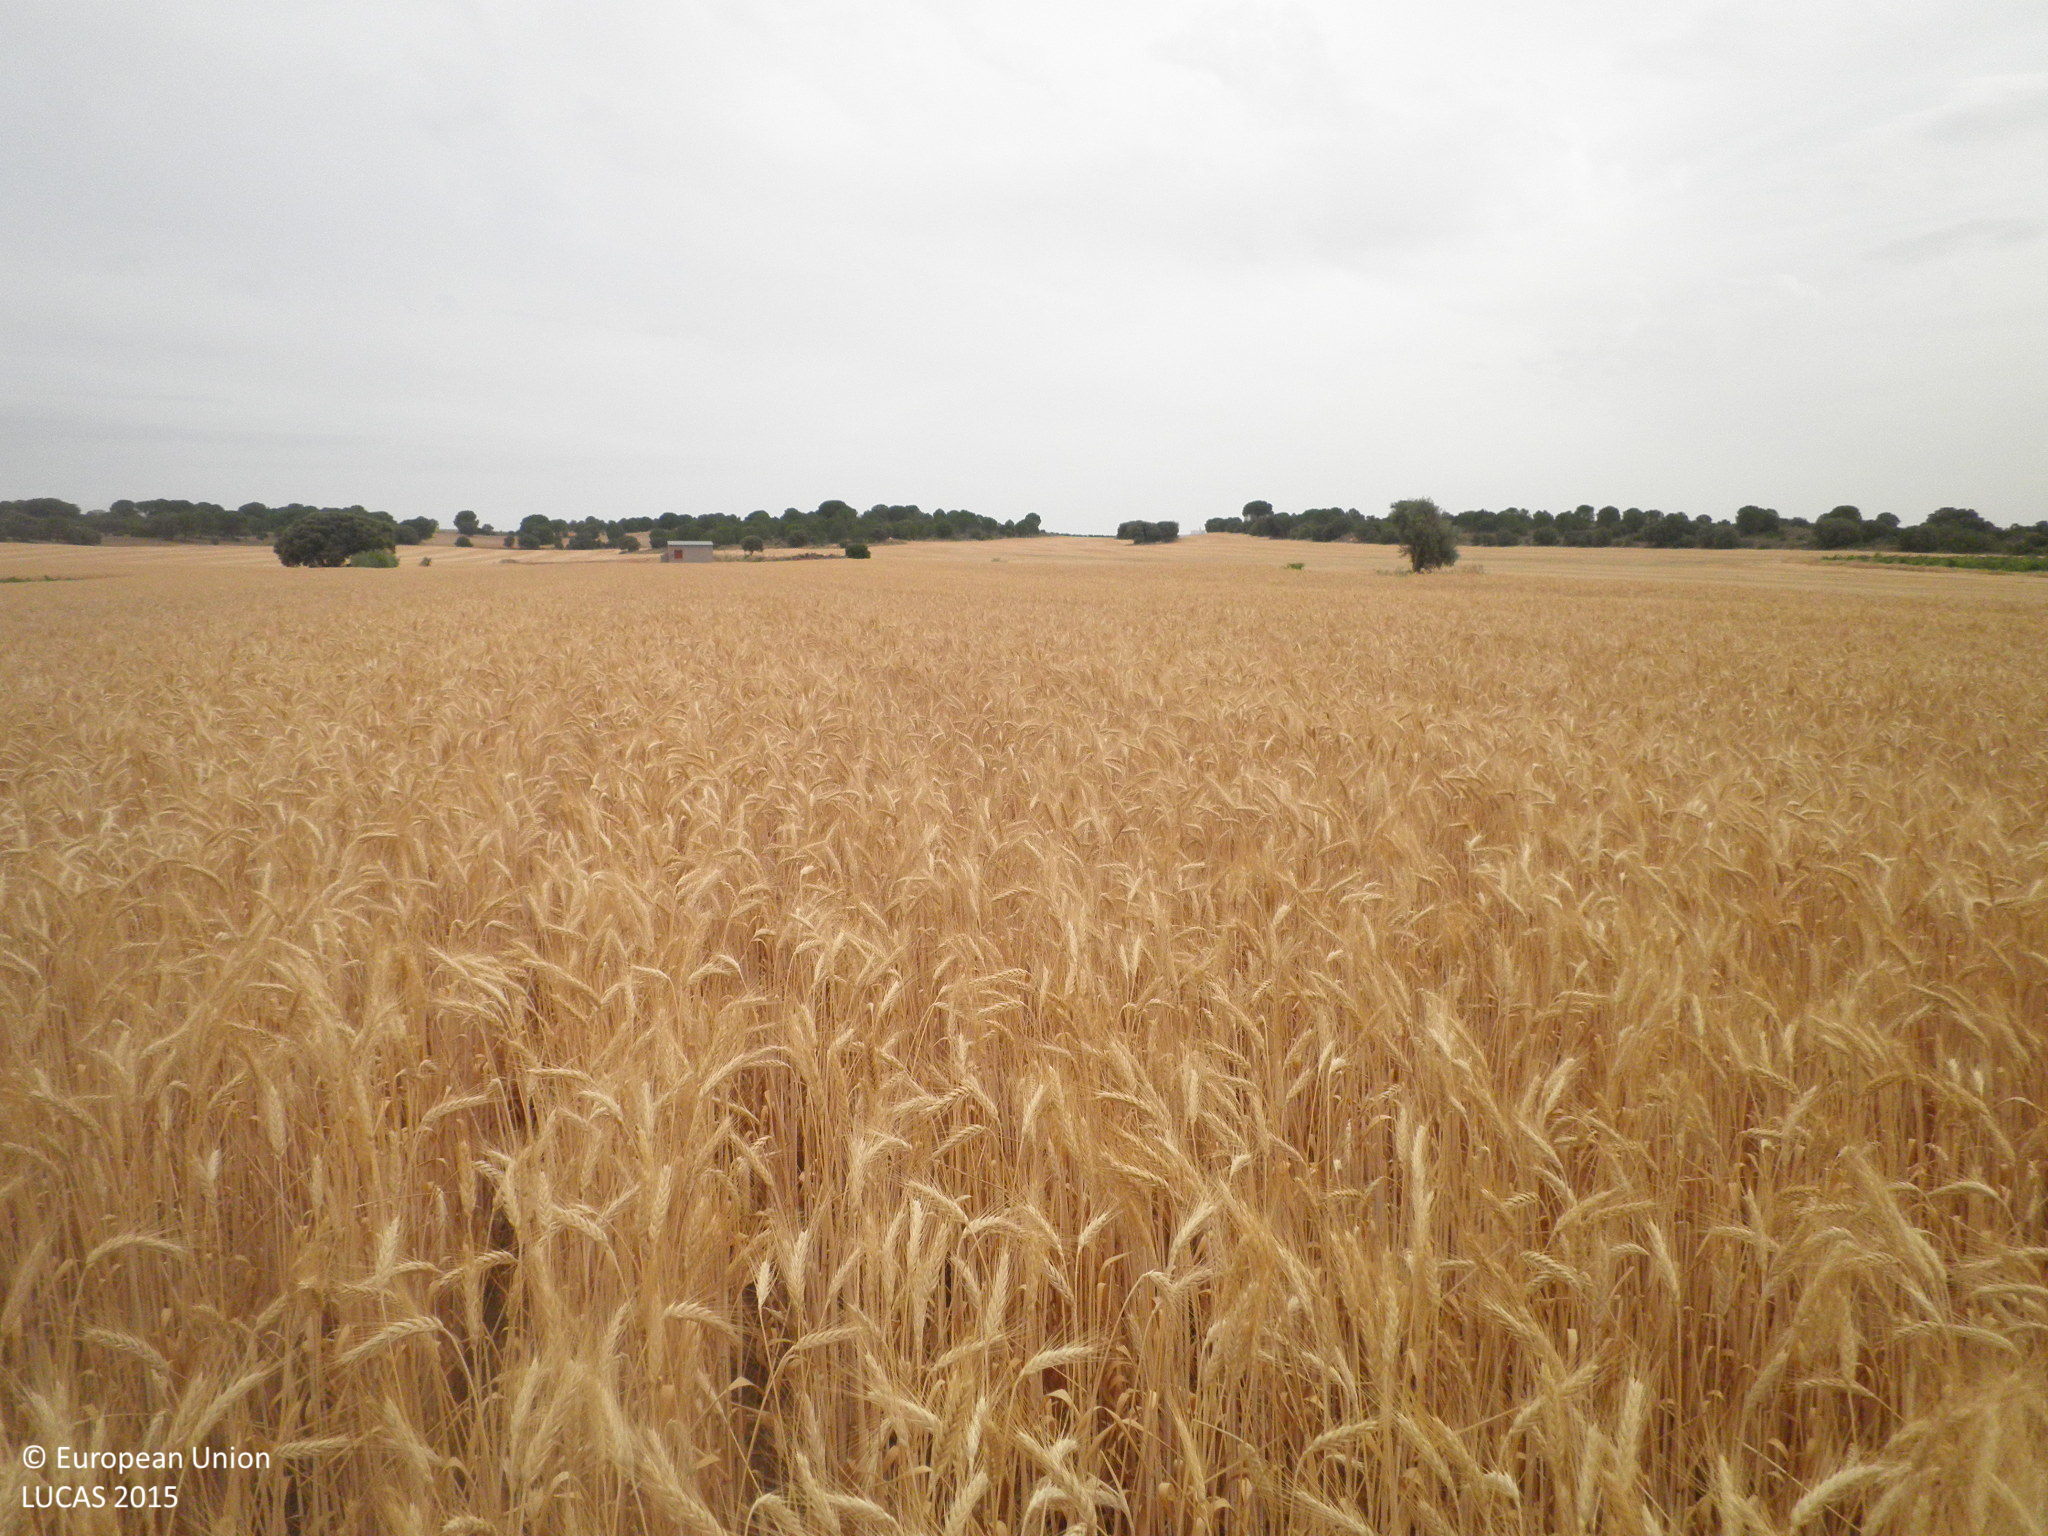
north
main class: Cropland
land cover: Durum wheat
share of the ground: > 75 %
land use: Agriculture (excluding fallow land and kitchen gardens)
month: July
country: ES
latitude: 39.4993
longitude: -2.6541
